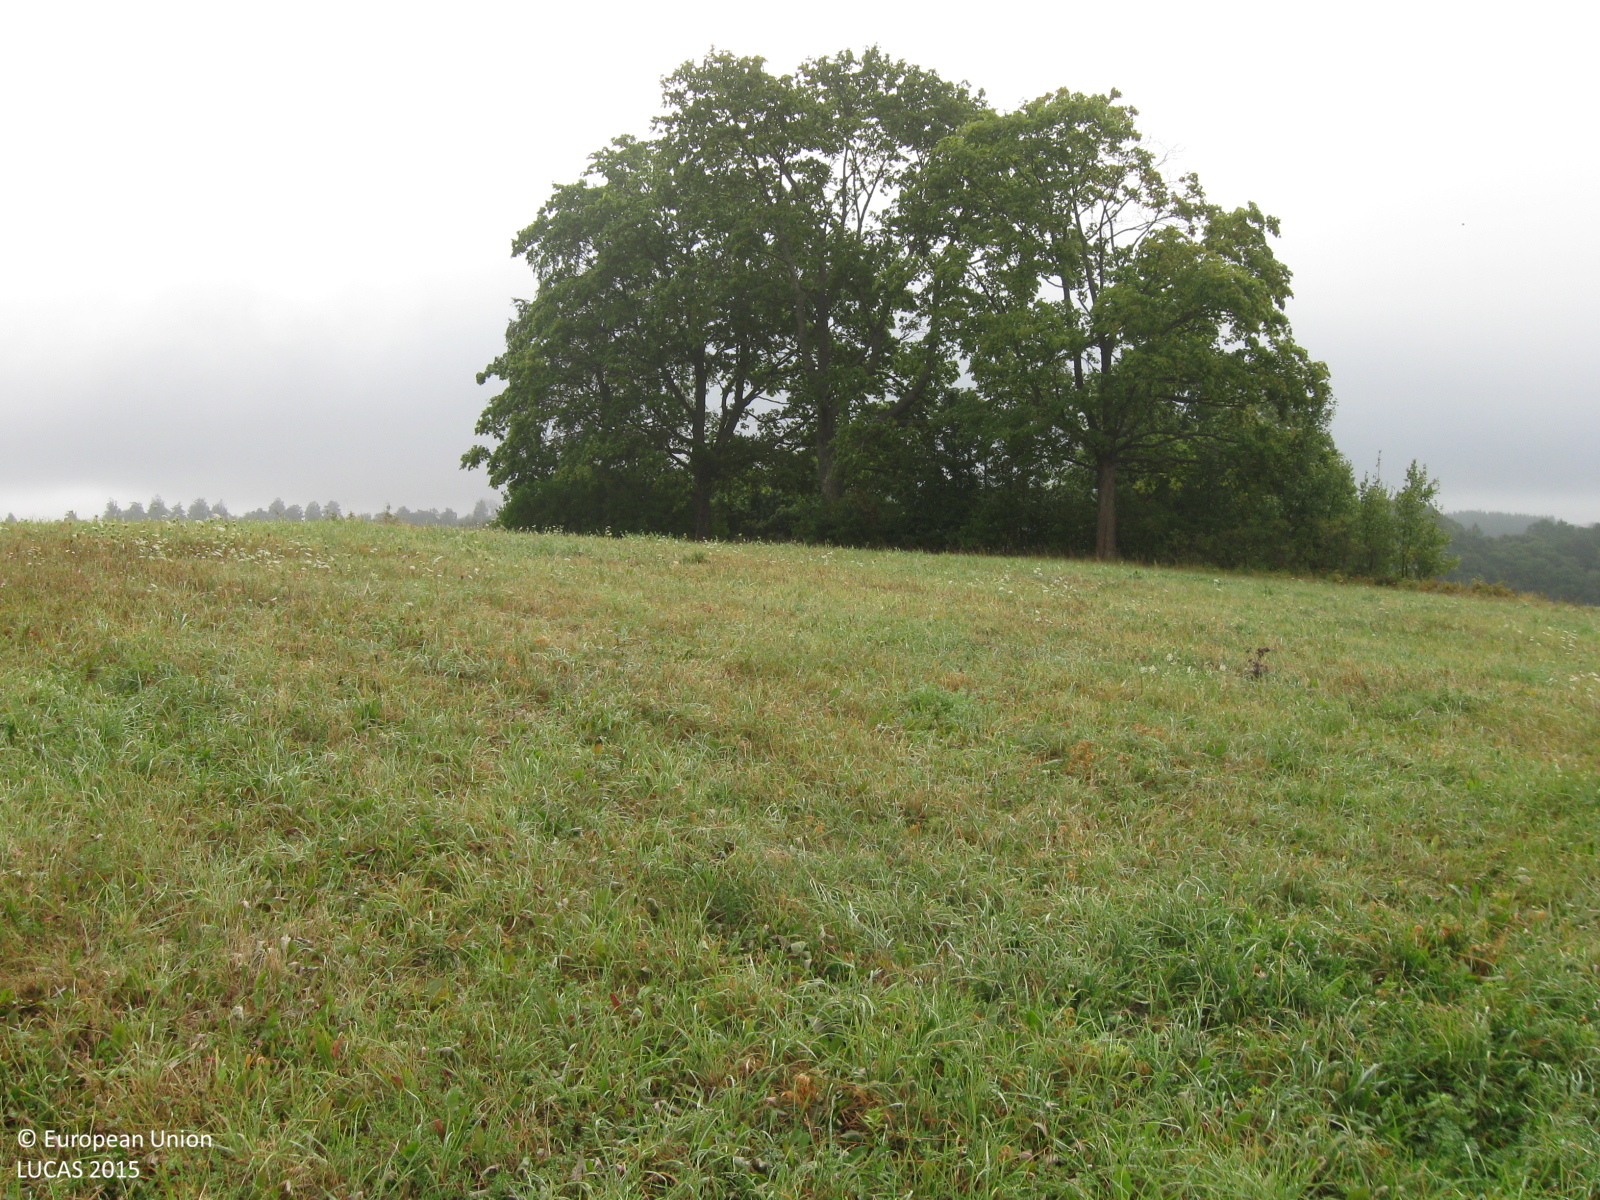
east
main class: Grassland
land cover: Grassland without tree/shrub cover
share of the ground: > 75 %
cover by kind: herbaceous plants 100 %
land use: Agriculture (excluding fallow land and kitchen gardens)
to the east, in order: Grassland without tree/shrub cover; Broadleaved woodland; Paved roads, cycling and walking lanes; Shruby margins; Broadleaved woodland; Spontaneously vegetated surfaces; Grassland without tree/shrub cover; Tracks; Grassland without tree/shrub cover
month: August
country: LT
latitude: 55.3402
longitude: 23.1757
